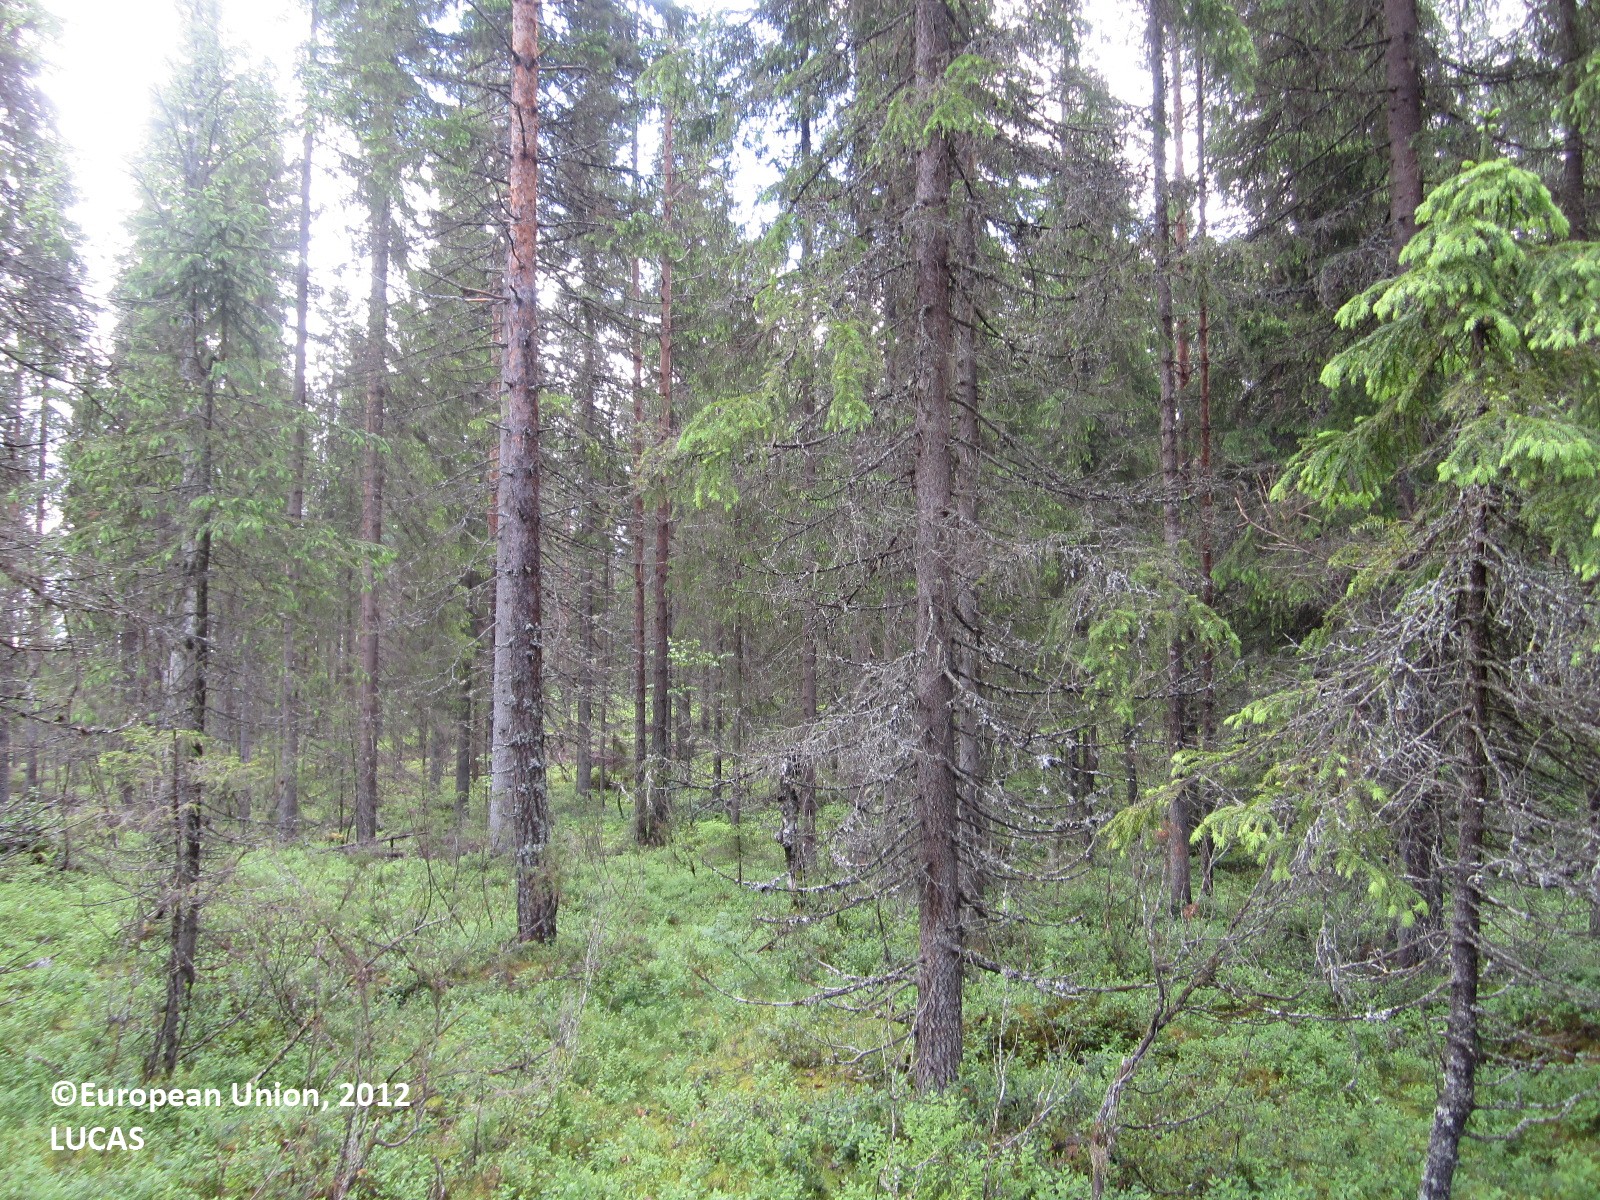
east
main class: Woodland
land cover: Spruce dominated coniferous woodland
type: boreal forest
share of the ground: > 75 %
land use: Forestry
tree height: > 5 m
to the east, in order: Spruce dominated coniferous woodland; Tracks; Spruce dominated coniferous woodland; Tracks; Spruce dominated coniferous woodland; Pine dominated coniferous woodland; Spruce dominated coniferous woodland; Tracks; Pine dominated coniferous woodland
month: June
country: FI
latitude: 64.4603
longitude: 29.6574
